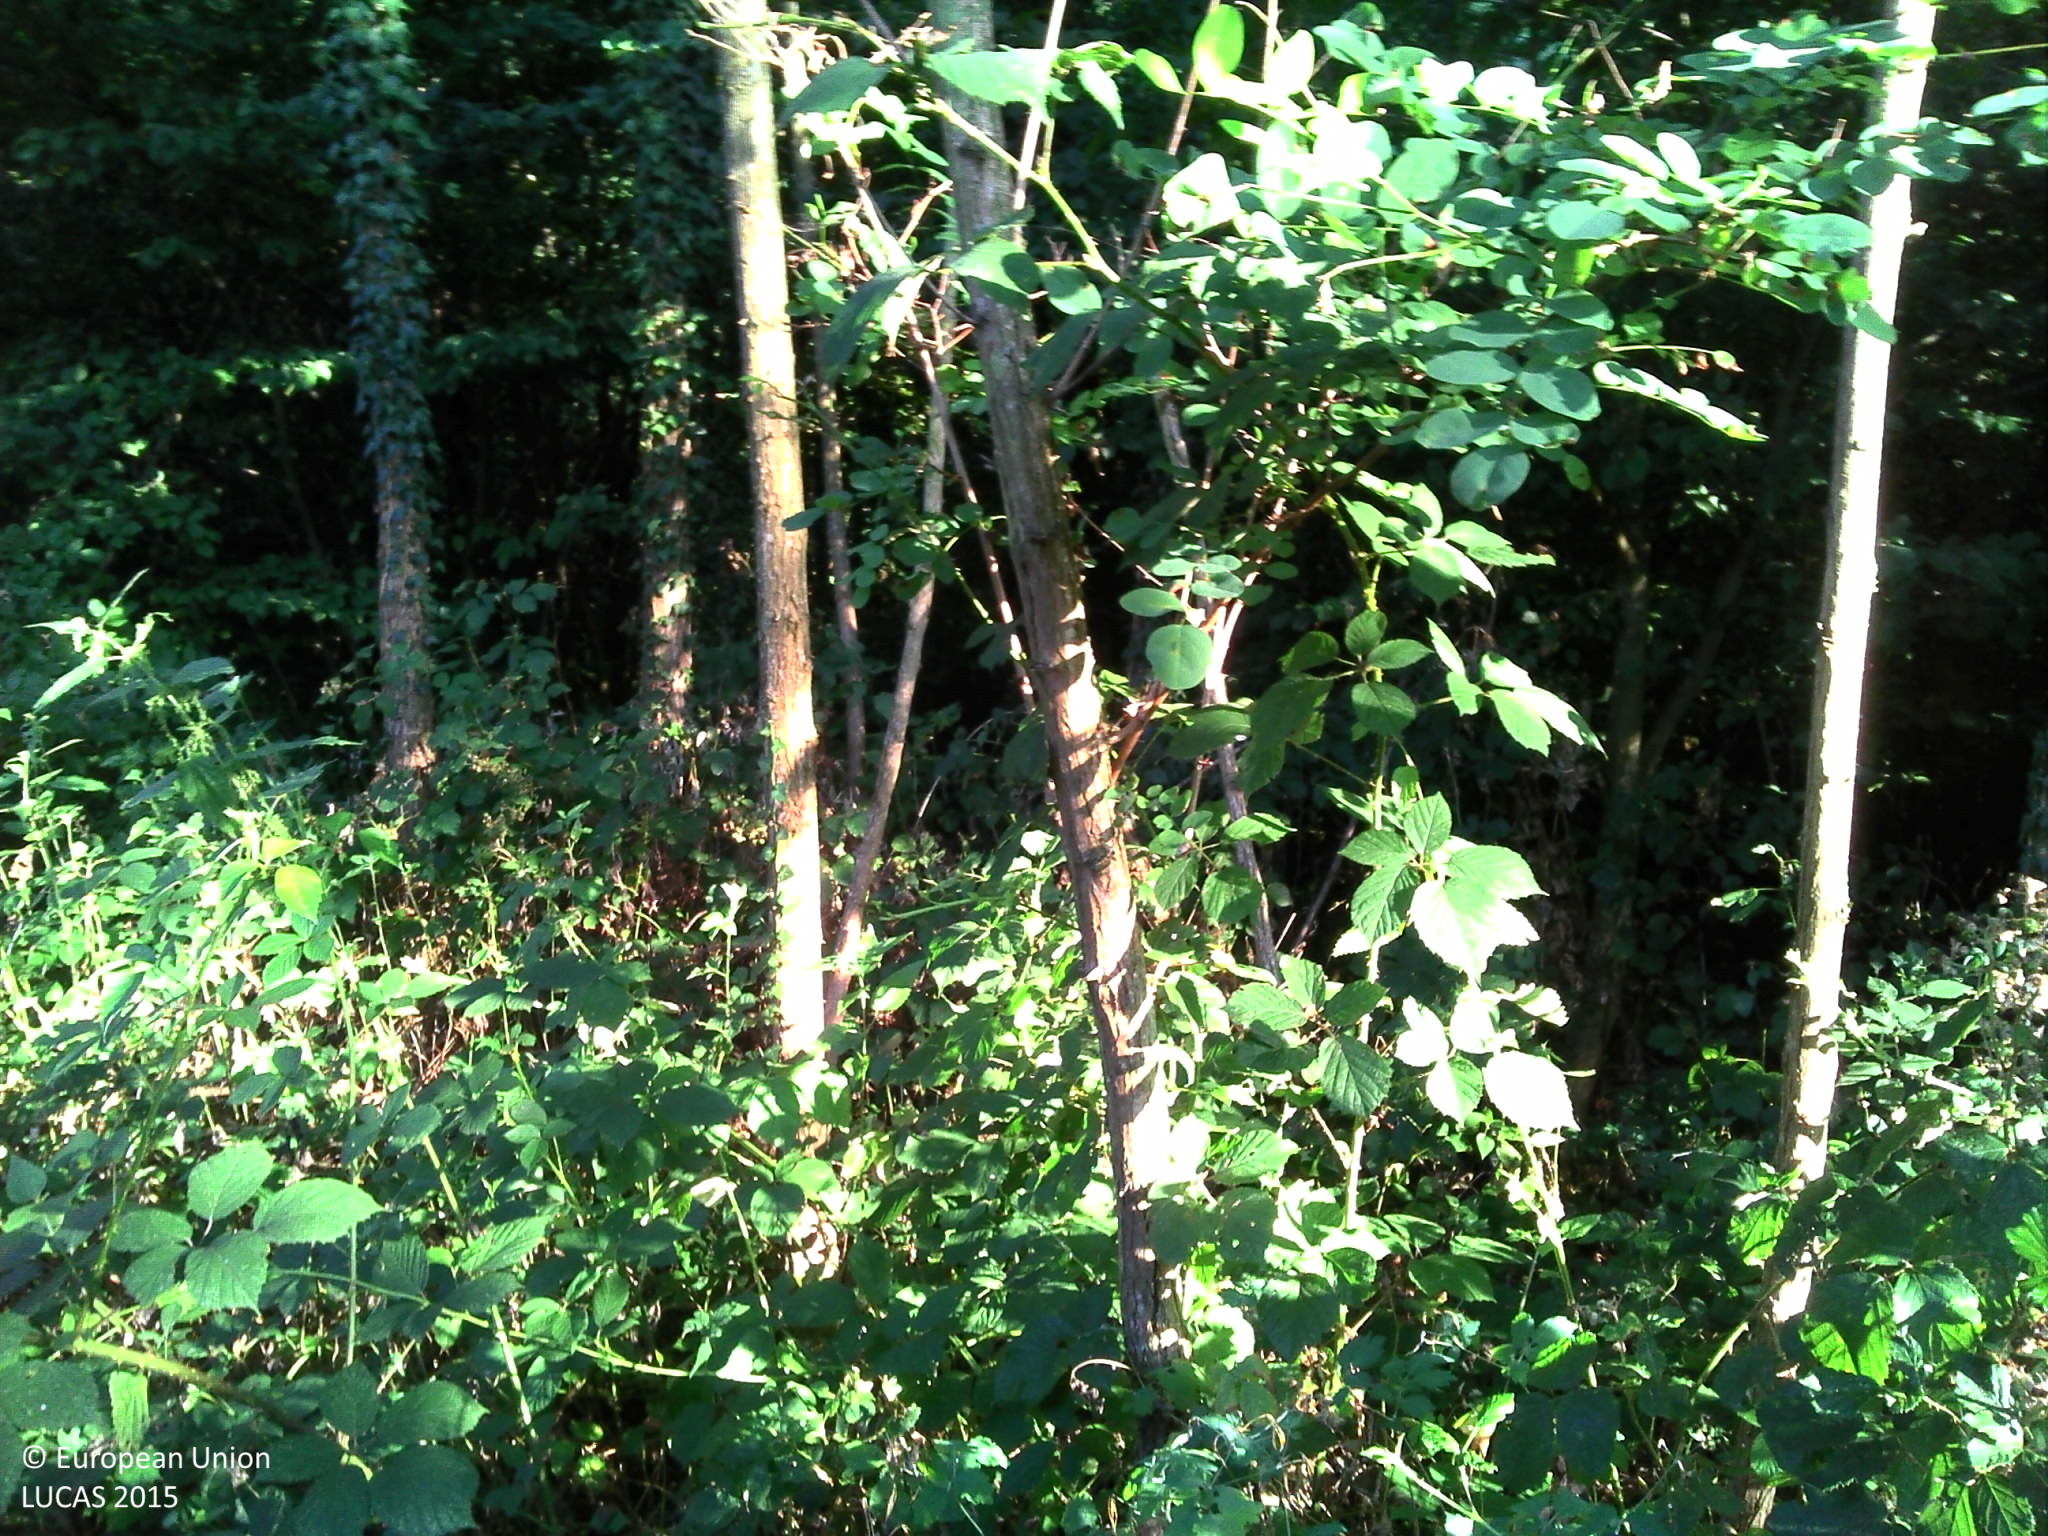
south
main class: Woodland
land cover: Broadleaved woodland
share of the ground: > 75 %
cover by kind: broadleaved forest trees 90 %, shrubs 5 %, herbaceous plants 5 %
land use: Forestry
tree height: > 5 m
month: July
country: FR
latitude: 45.4788
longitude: 5.0536
